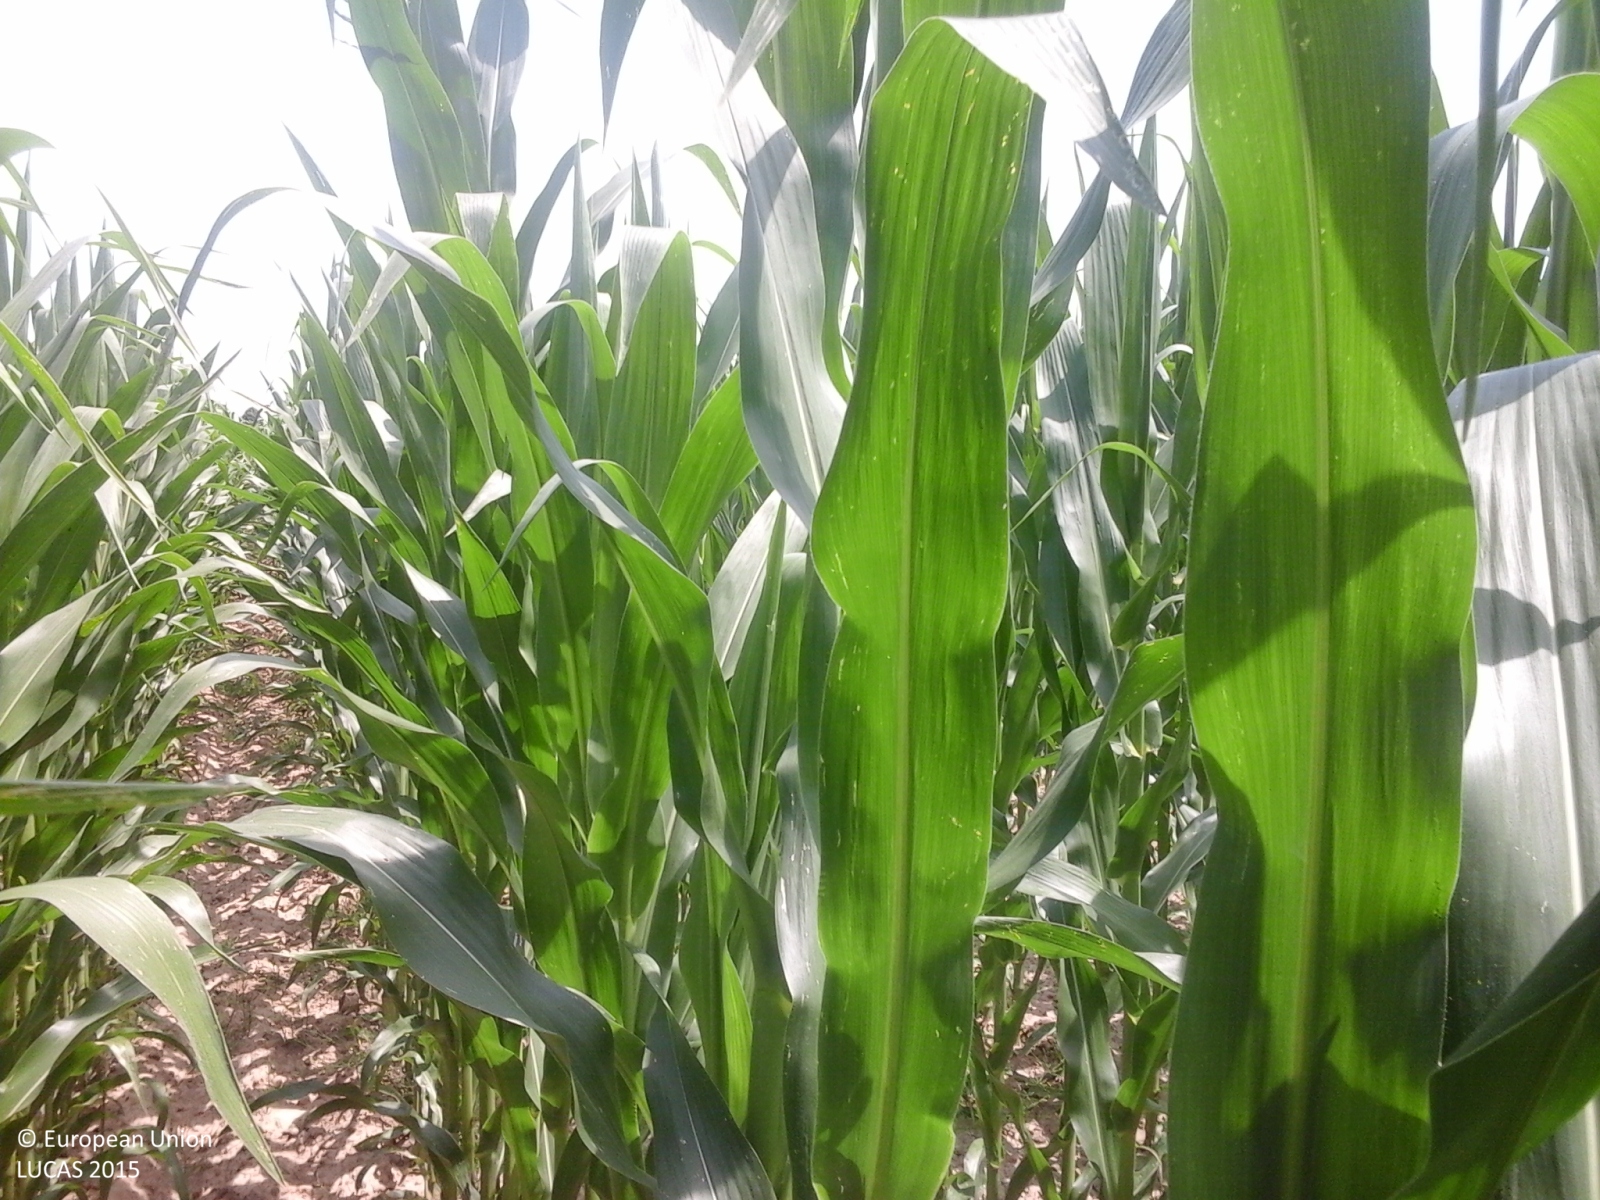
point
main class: Cropland
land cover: Maize
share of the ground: > 75 %
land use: Agriculture (excluding fallow land and kitchen gardens)
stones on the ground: < 10 %
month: June
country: IT
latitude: 44.9928
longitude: 8.7973
